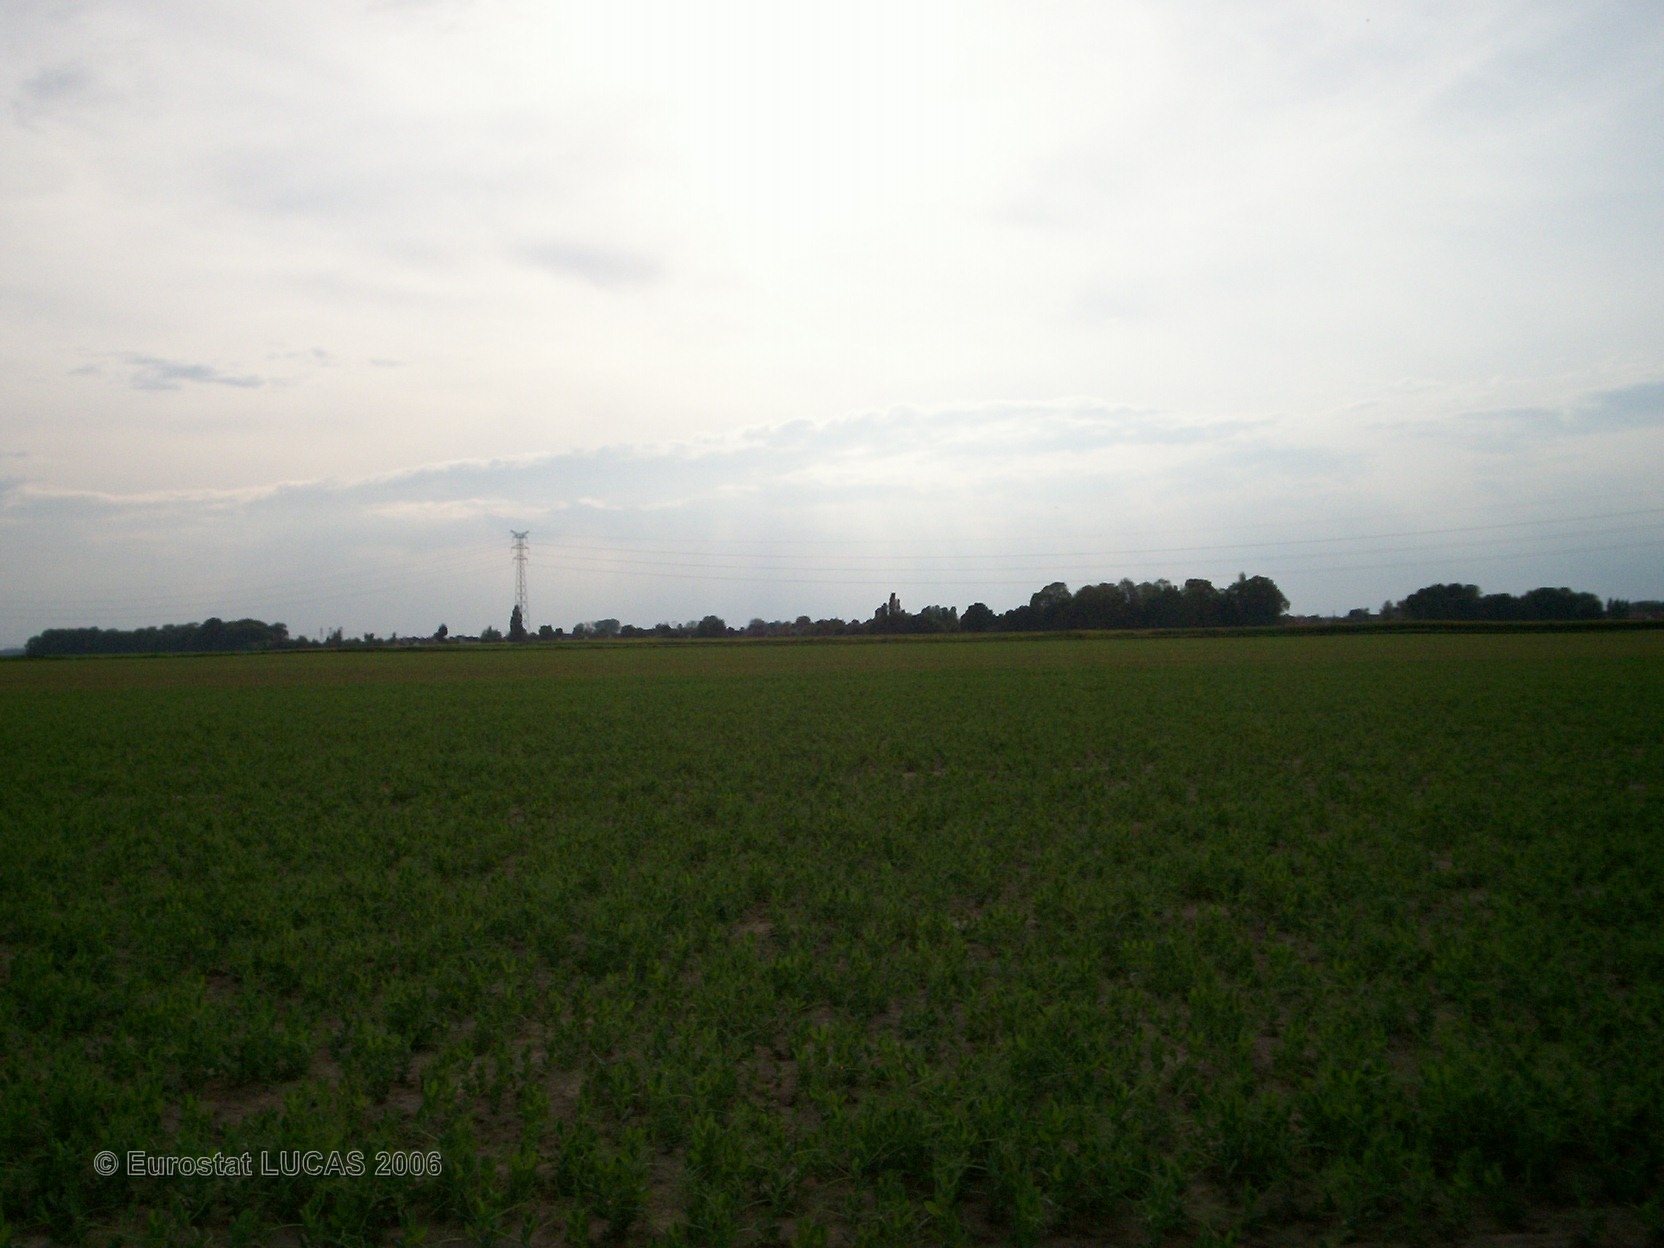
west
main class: Cropland
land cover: Dry pulses
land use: Agriculture (excluding fallow land and kitchen gardens)
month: May
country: FR
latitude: 48.5836
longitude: 2.7925
